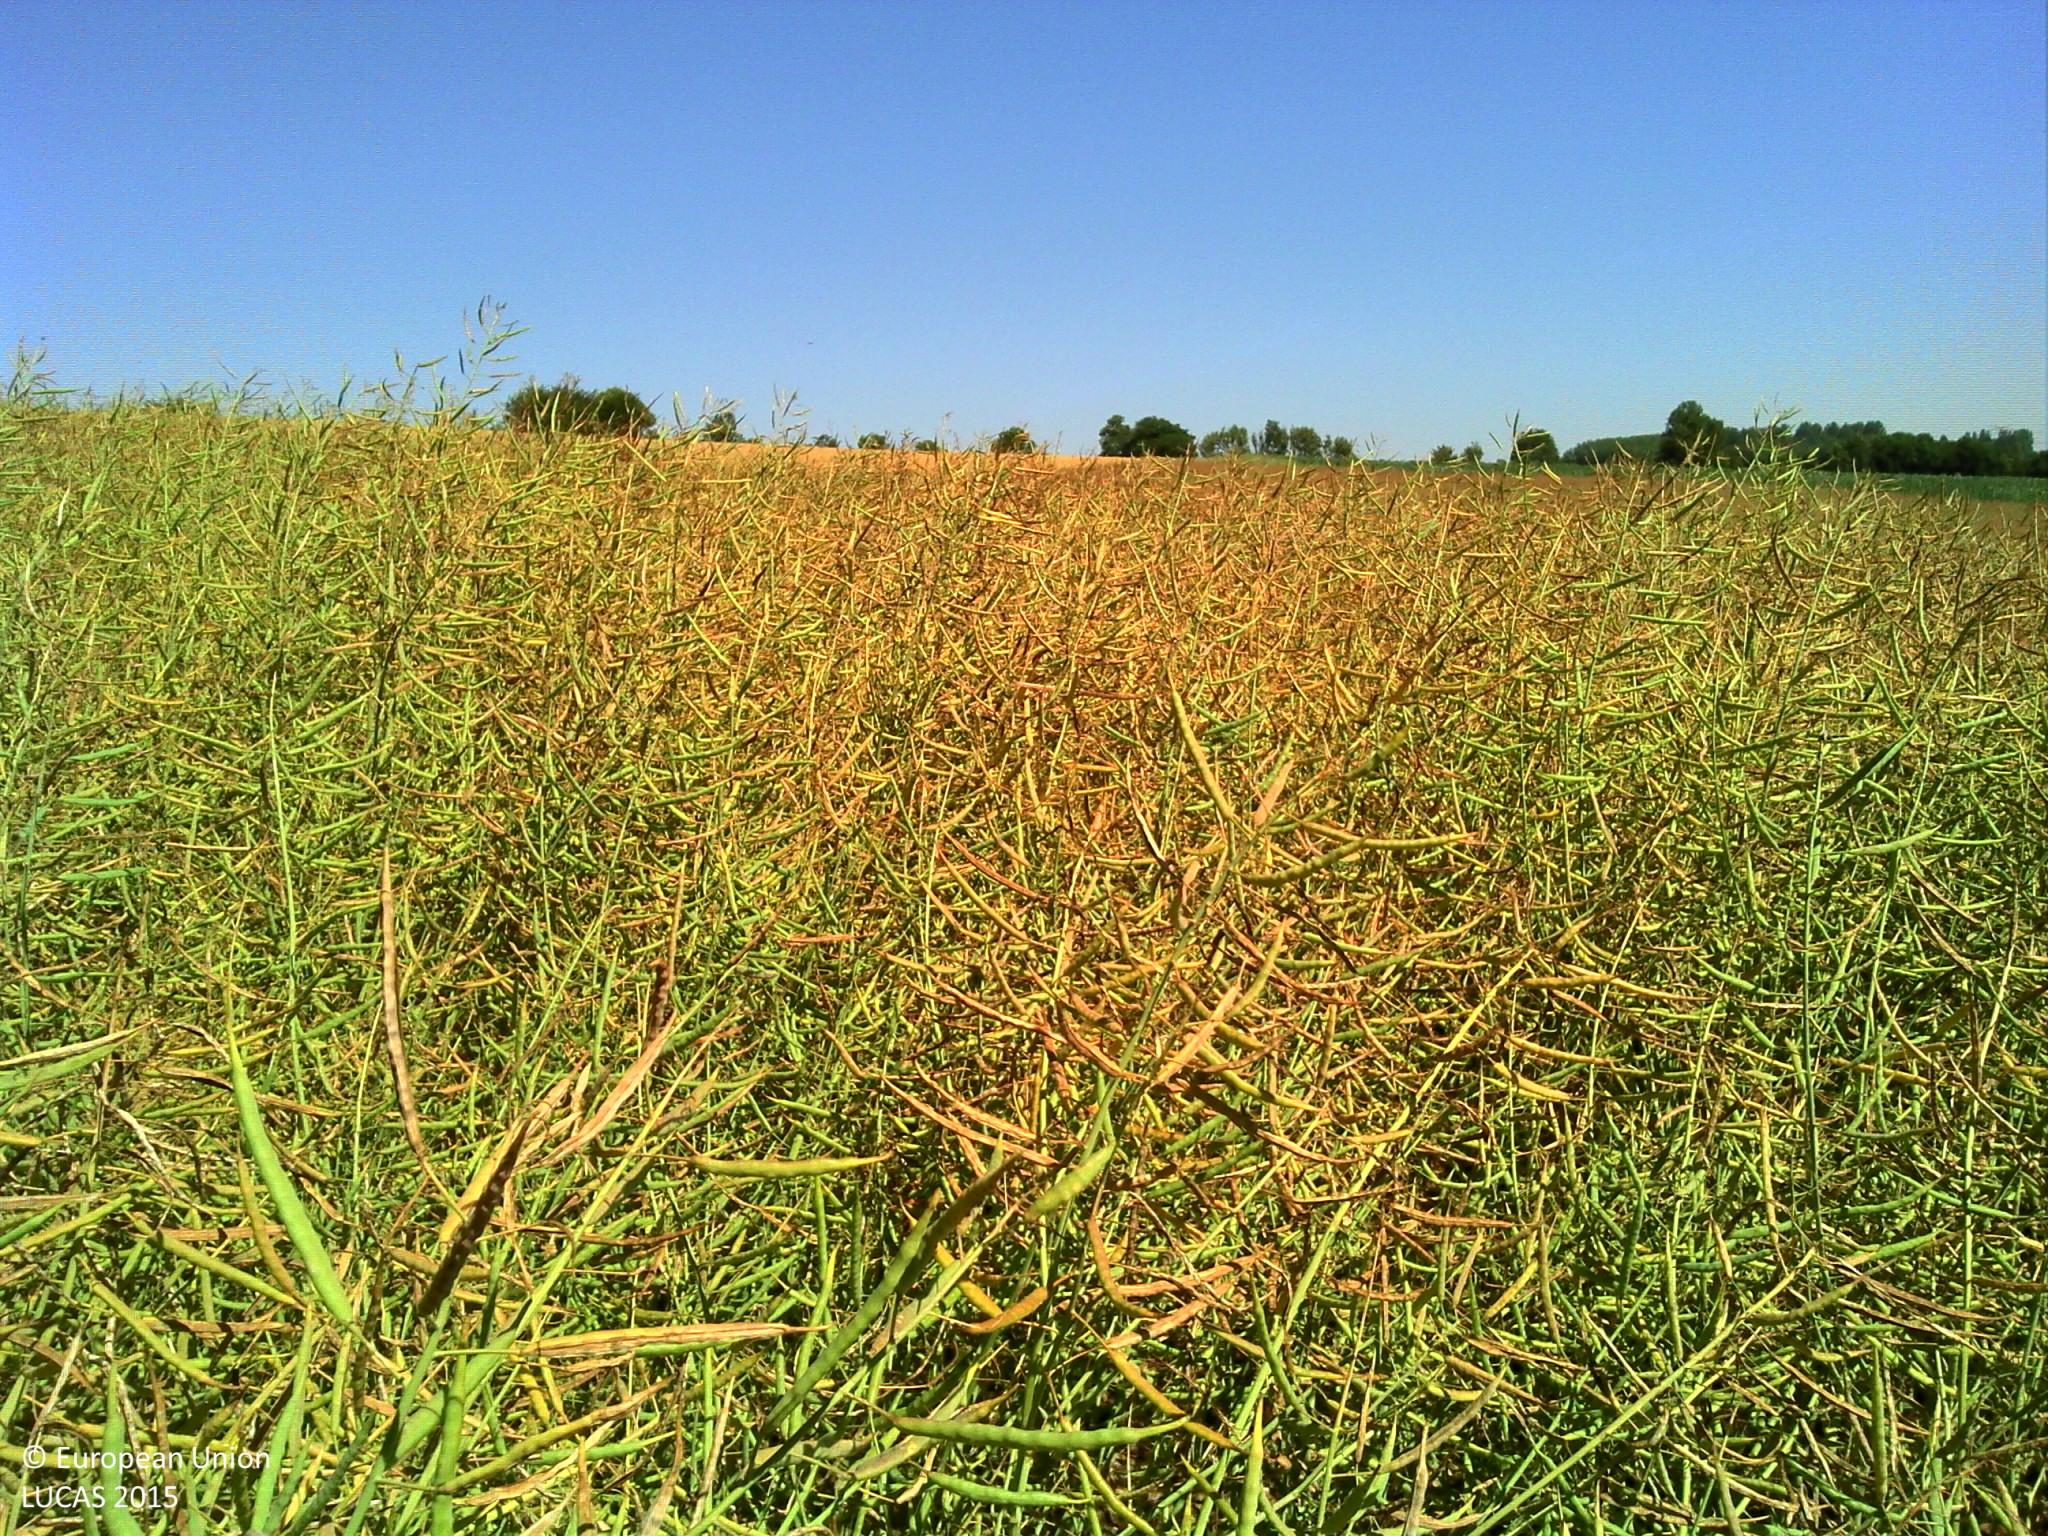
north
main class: Cropland
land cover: Rape and turnip rape
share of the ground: > 75 %
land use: Agriculture (excluding fallow land and kitchen gardens)
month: July
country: FR
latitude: 50.2563
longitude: 2.1448
